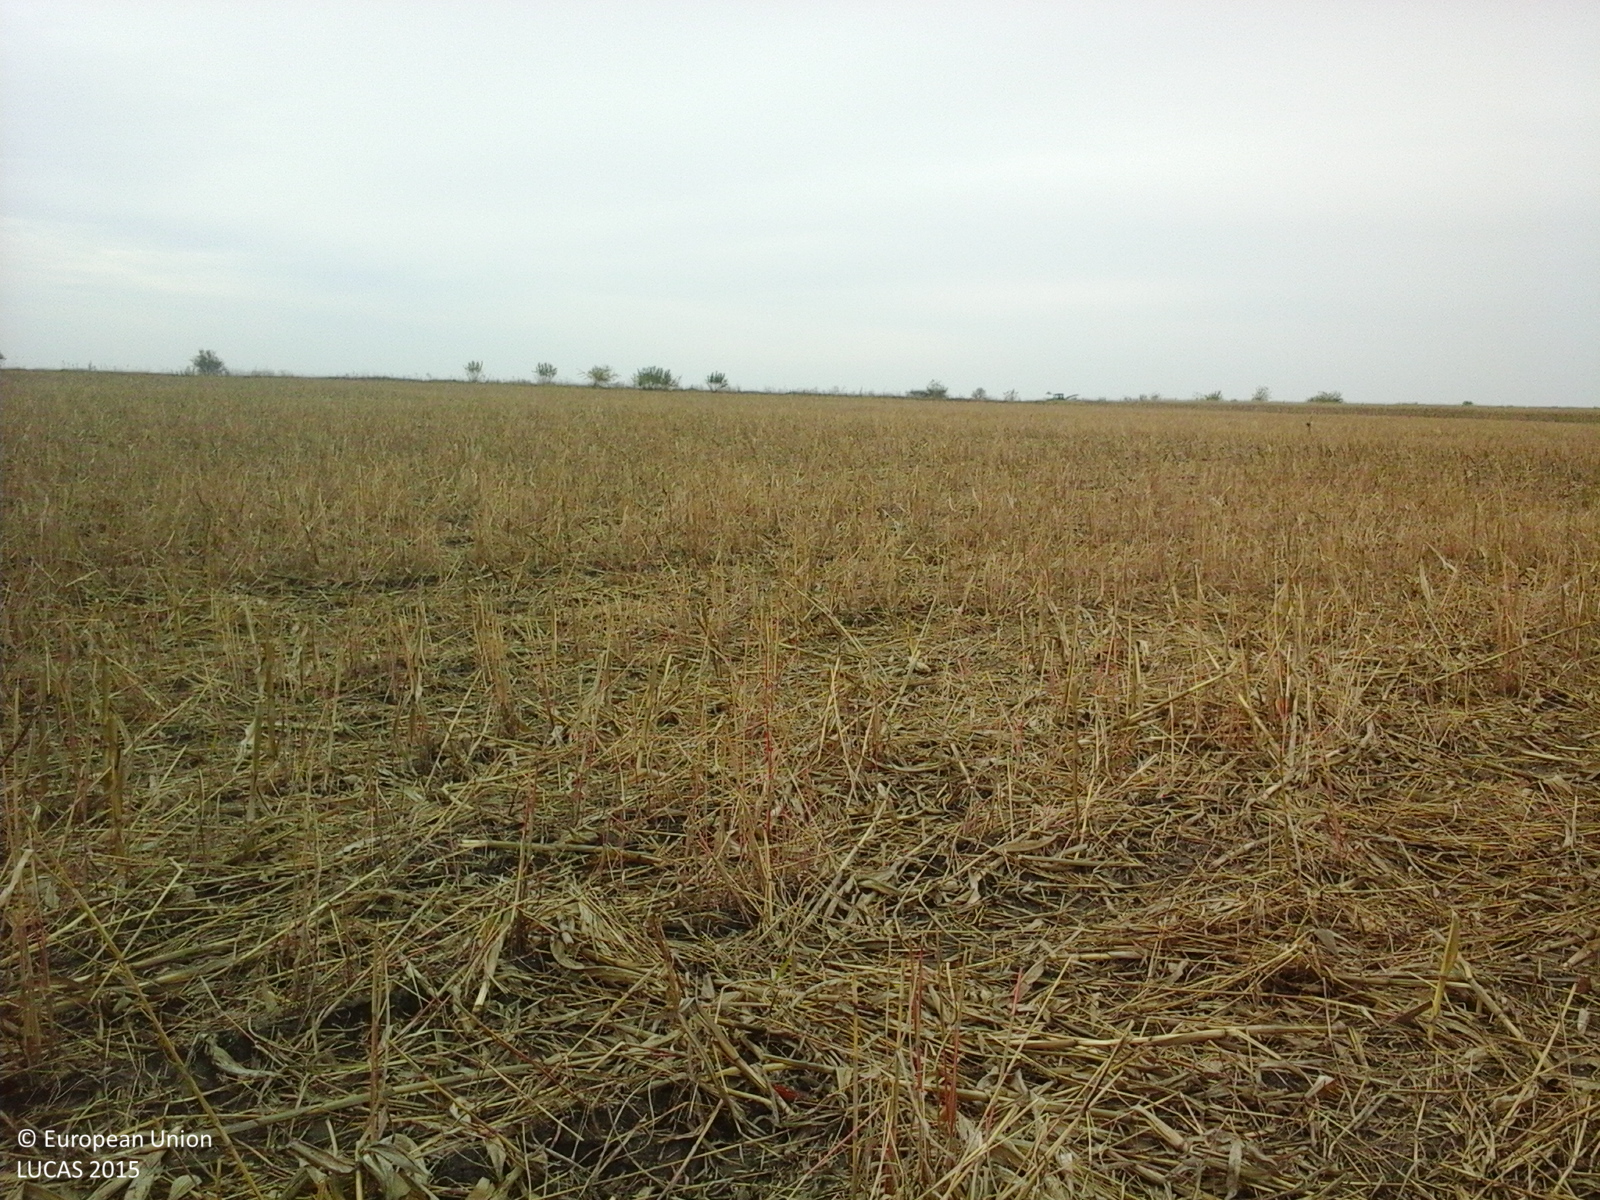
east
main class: Cropland
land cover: Maize
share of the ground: 10 - 25 %
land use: Agriculture (excluding fallow land and kitchen gardens)
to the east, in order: Maize
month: October
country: RO
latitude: 44.8518
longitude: 26.2977
